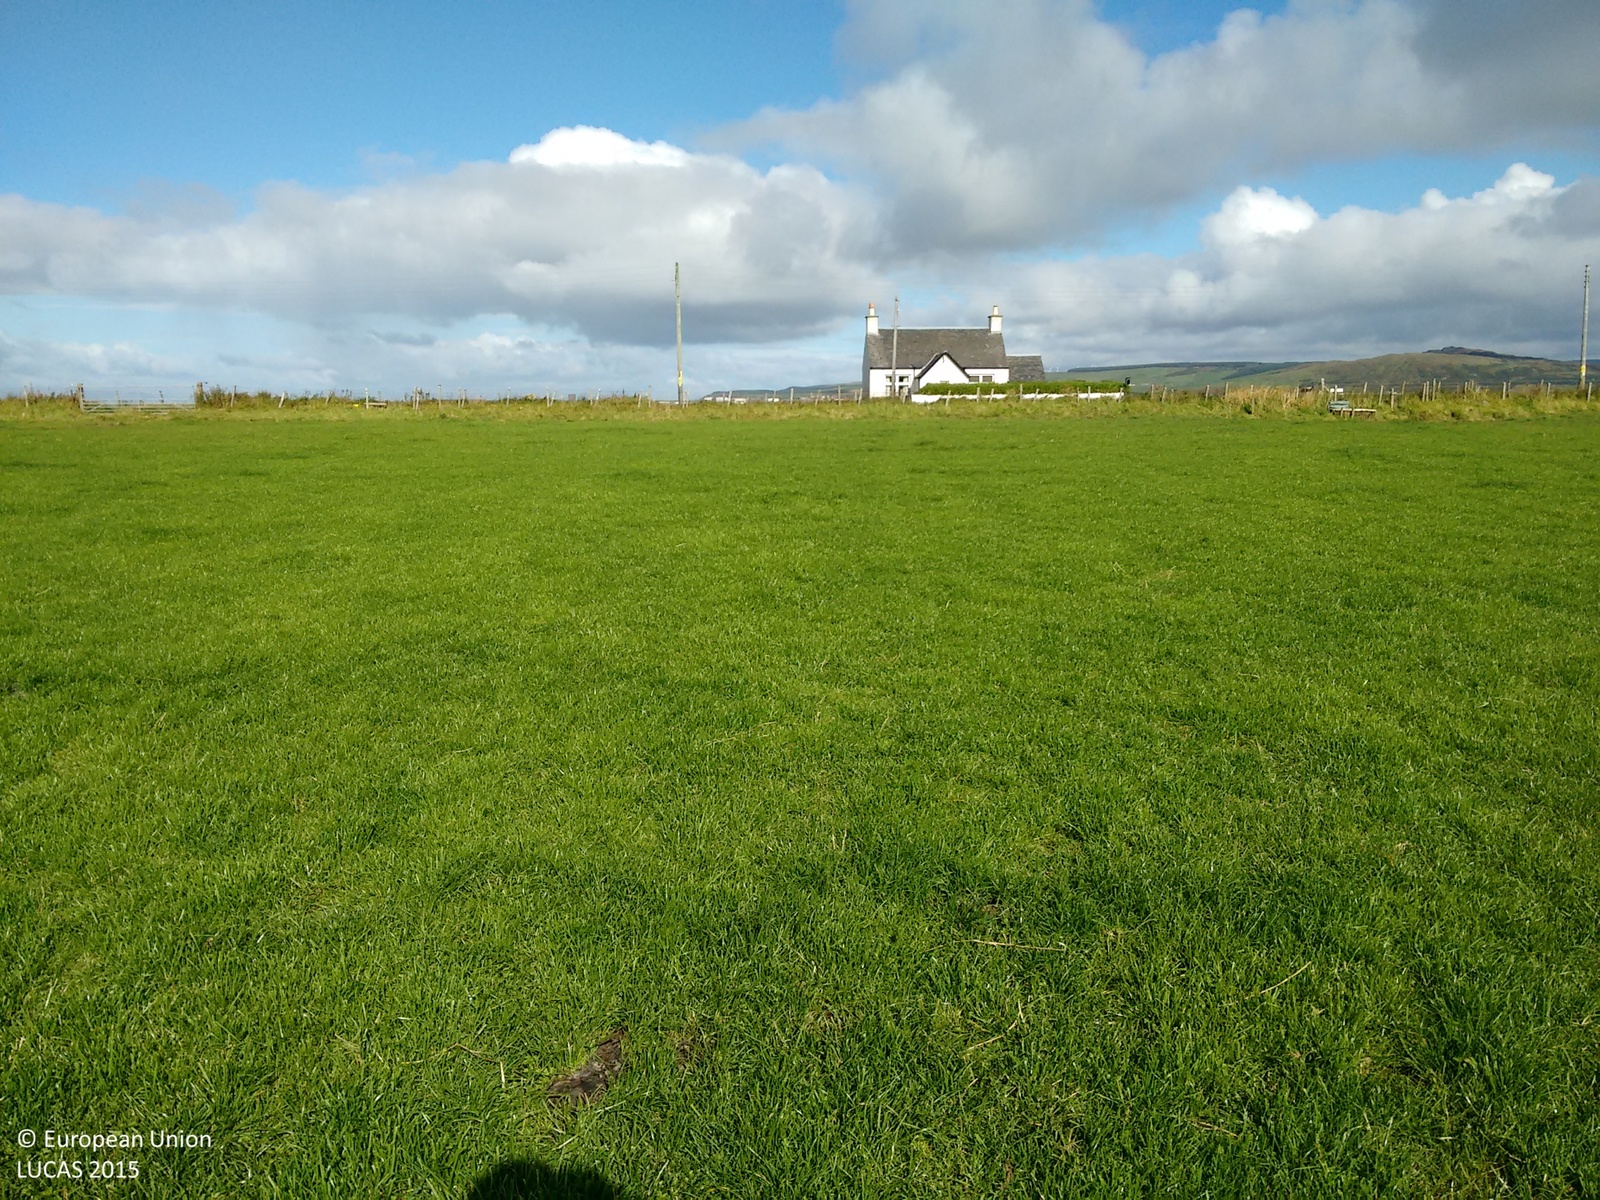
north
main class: Grassland
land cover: Grassland without tree/shrub cover
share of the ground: > 75 %
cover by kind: herbaceous plants 100 %
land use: Agriculture (excluding fallow land and kitchen gardens)
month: September
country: GB
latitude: 55.4155
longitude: -5.6896
